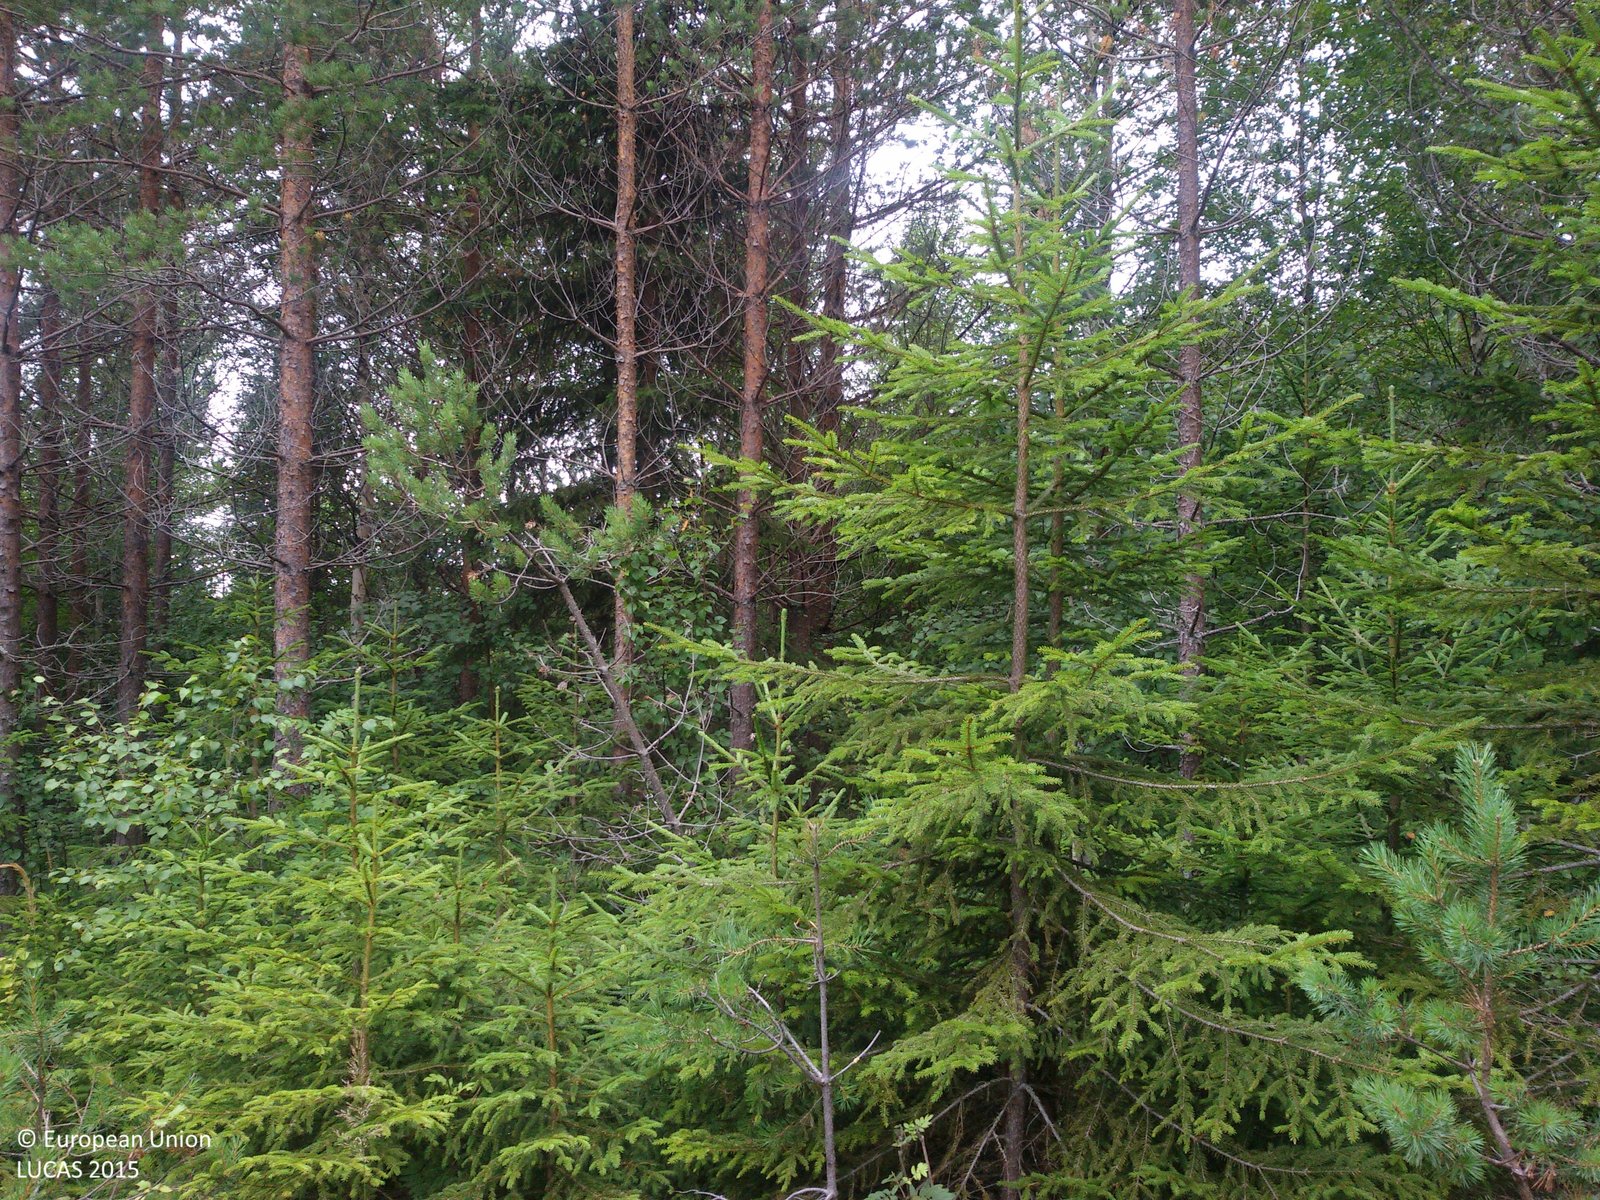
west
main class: Woodland
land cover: Other coniferous woodland
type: boreal forest
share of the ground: > 75 %
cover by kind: coniferous forest trees 65 %, herbaceous plants 20 %, broadleaved forest trees 15 %
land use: Forestry
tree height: < 5 m
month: August
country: SE
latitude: 60.8562
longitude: 16.6324
